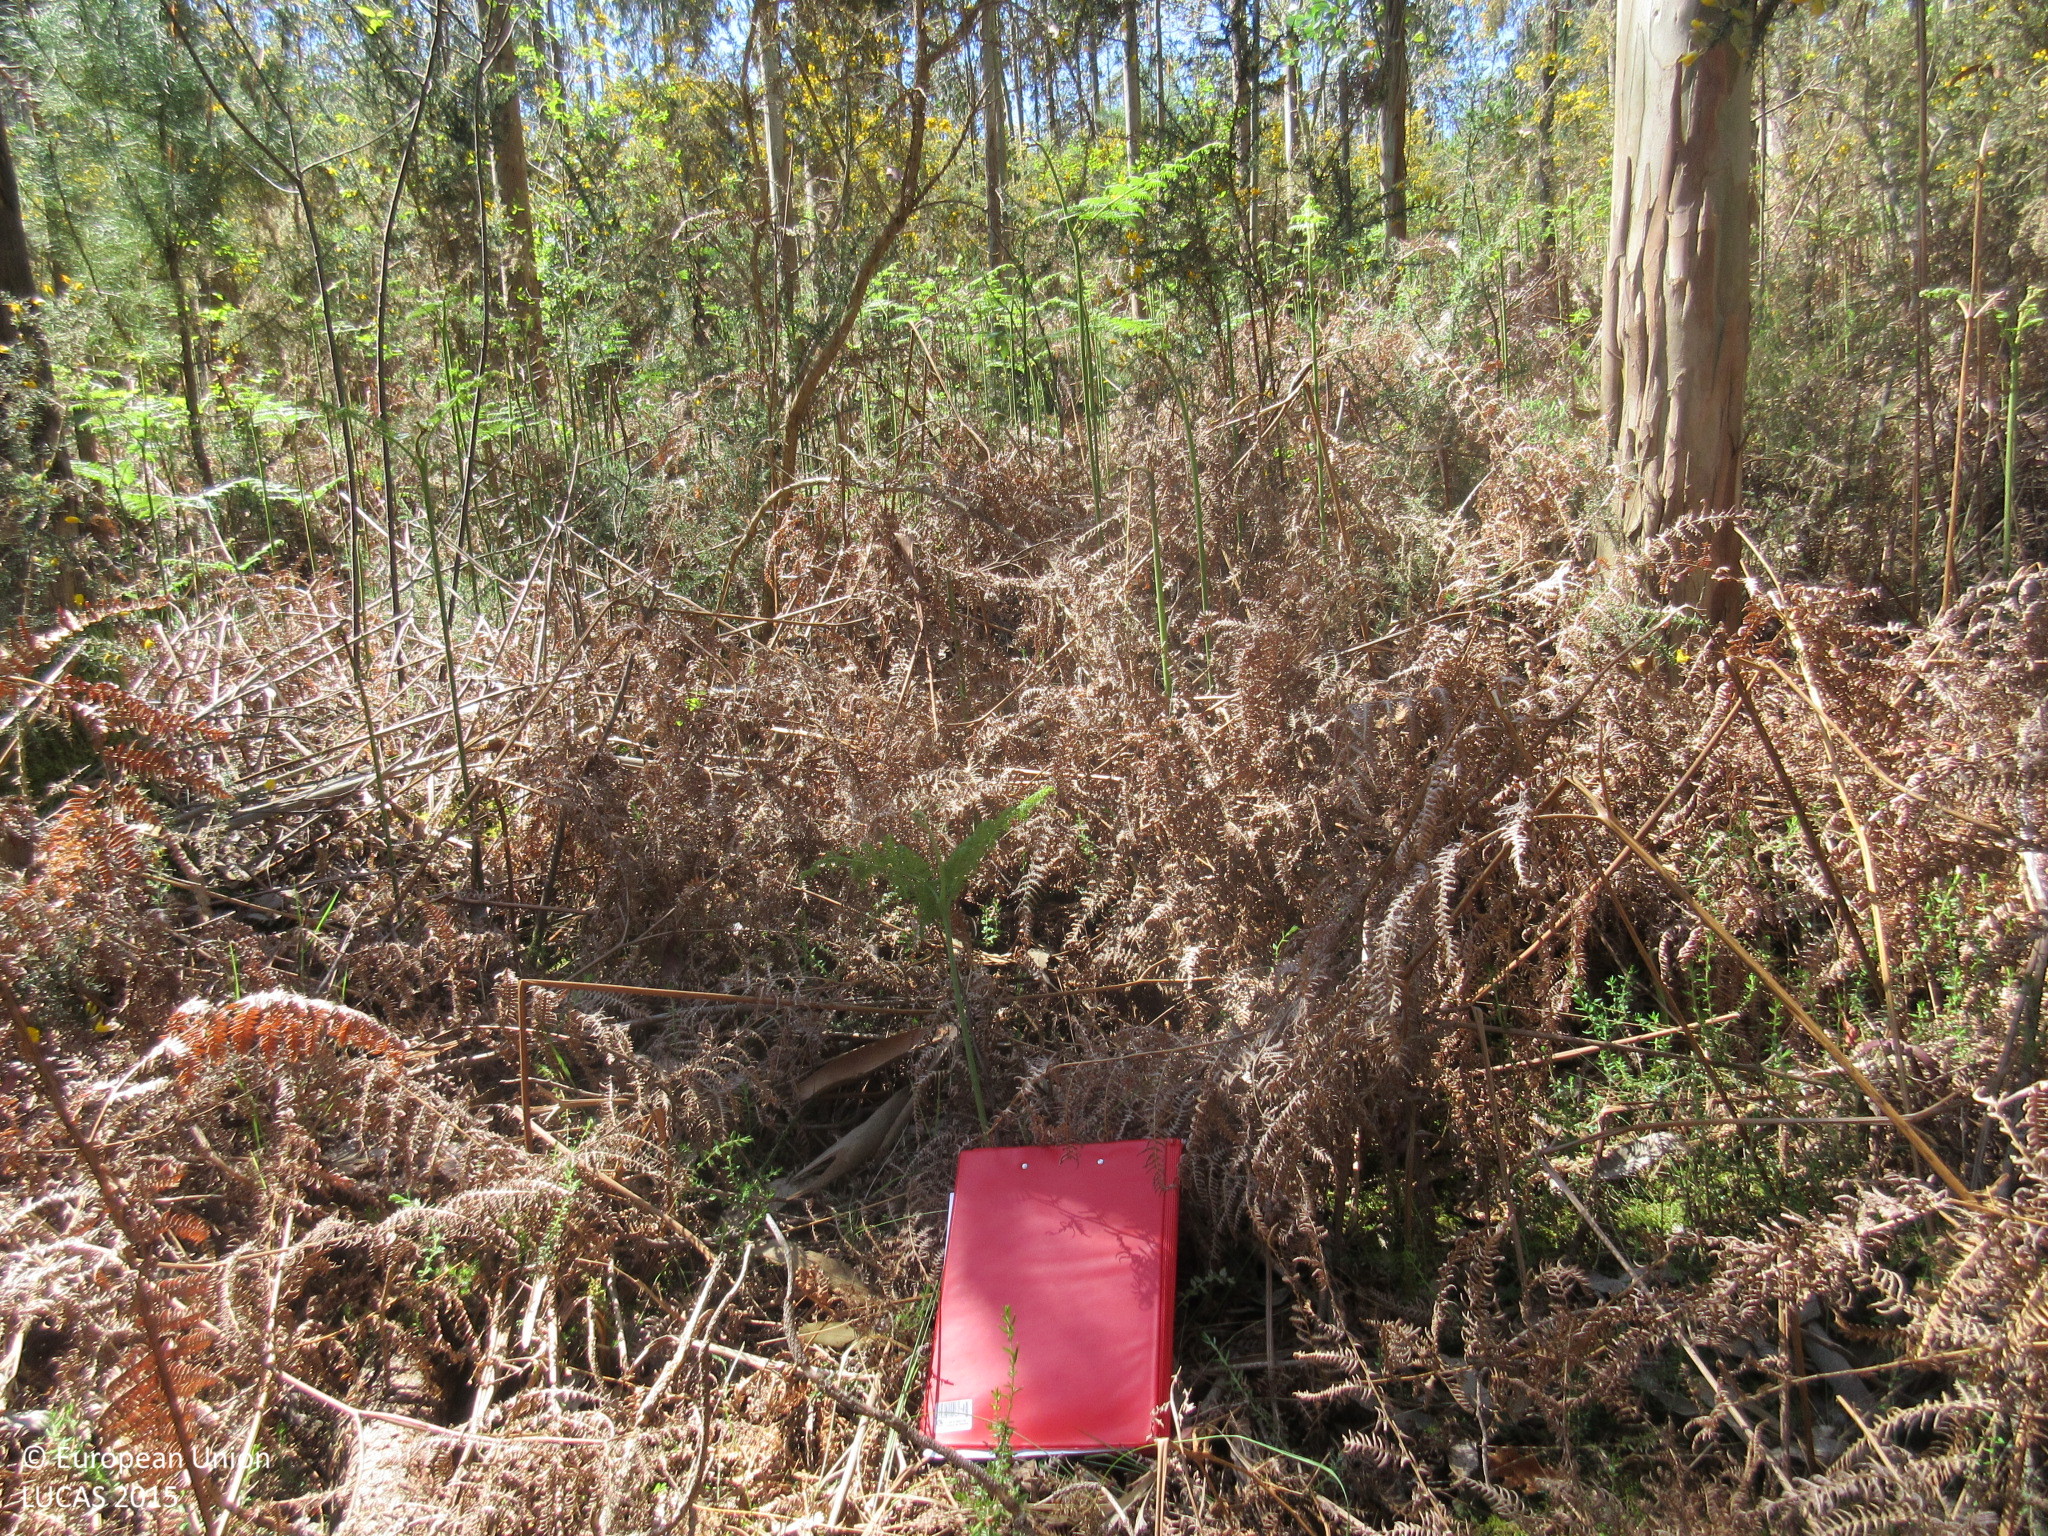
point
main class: Woodland
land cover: Other mixed woodland
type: exotic forest
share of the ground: > 75 %
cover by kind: broadleaved forest trees 50 %, coniferous forest trees 45 %, shrubs 5 %
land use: Forestry
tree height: > 5 m
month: April
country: ES
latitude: 43.5056
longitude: -7.0007
